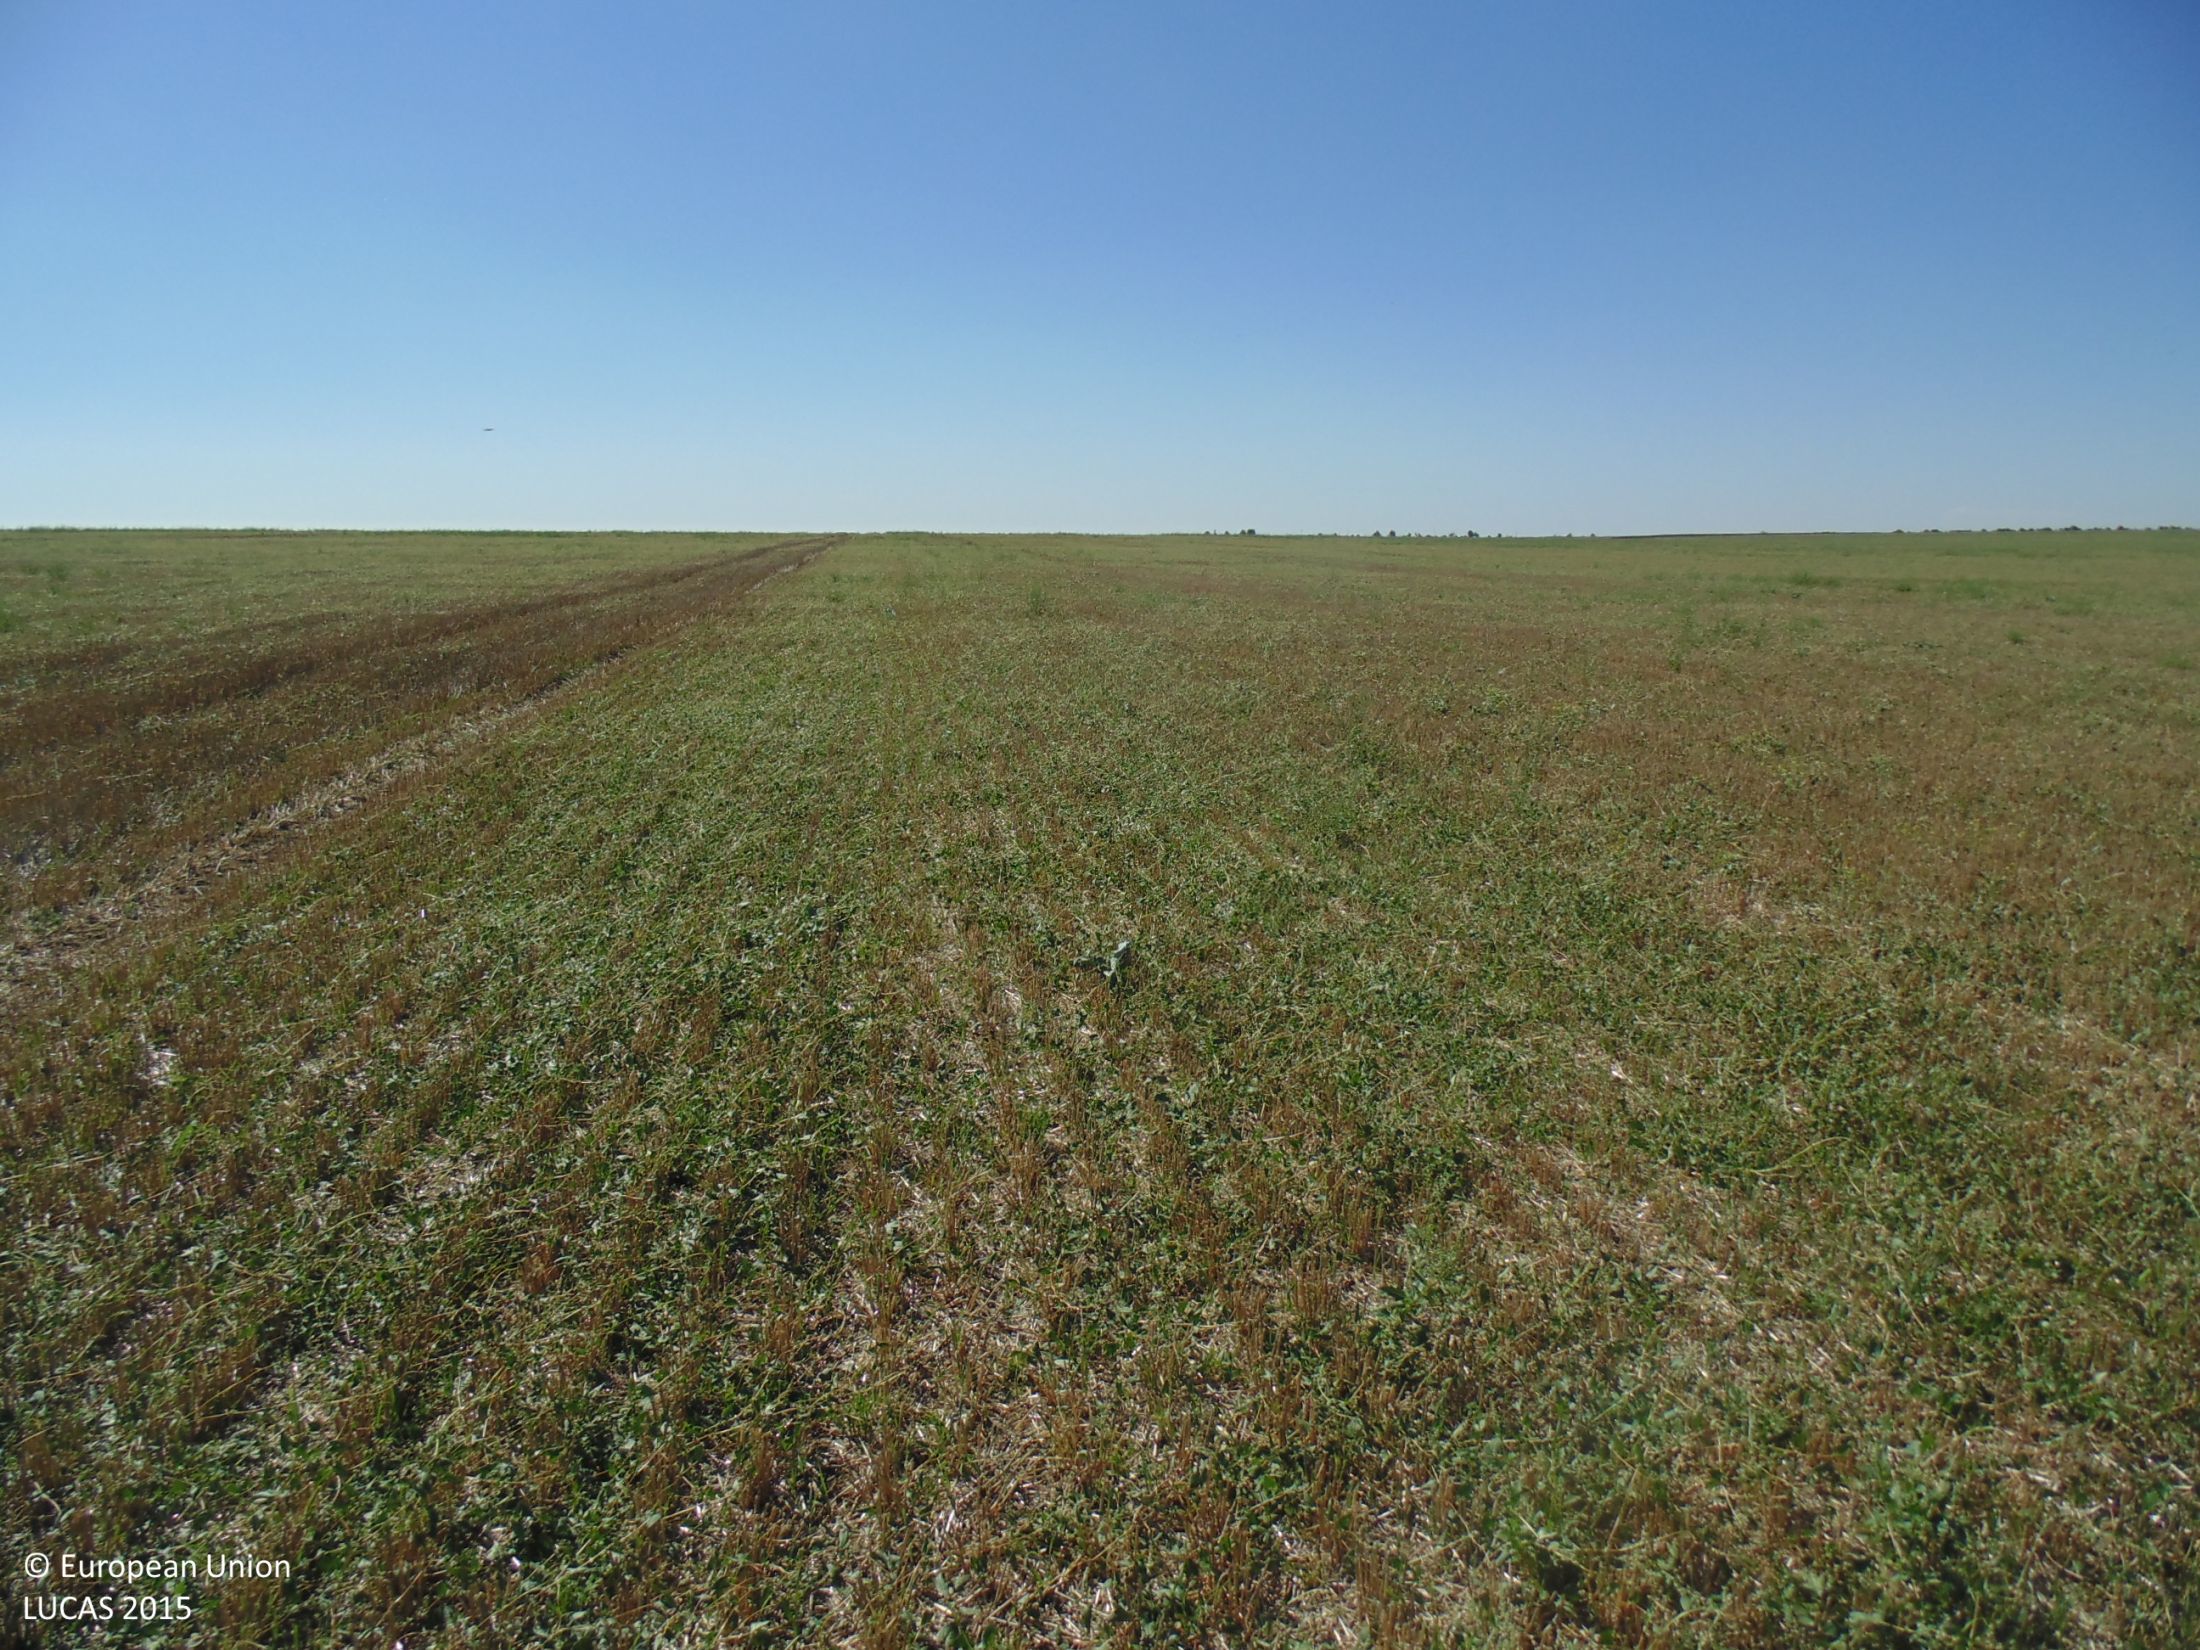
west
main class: Cropland
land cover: Common wheat
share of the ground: 50 - 75 %
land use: Agriculture (excluding fallow land and kitchen gardens)
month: September
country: BG
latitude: 43.7561
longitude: 27.1525
